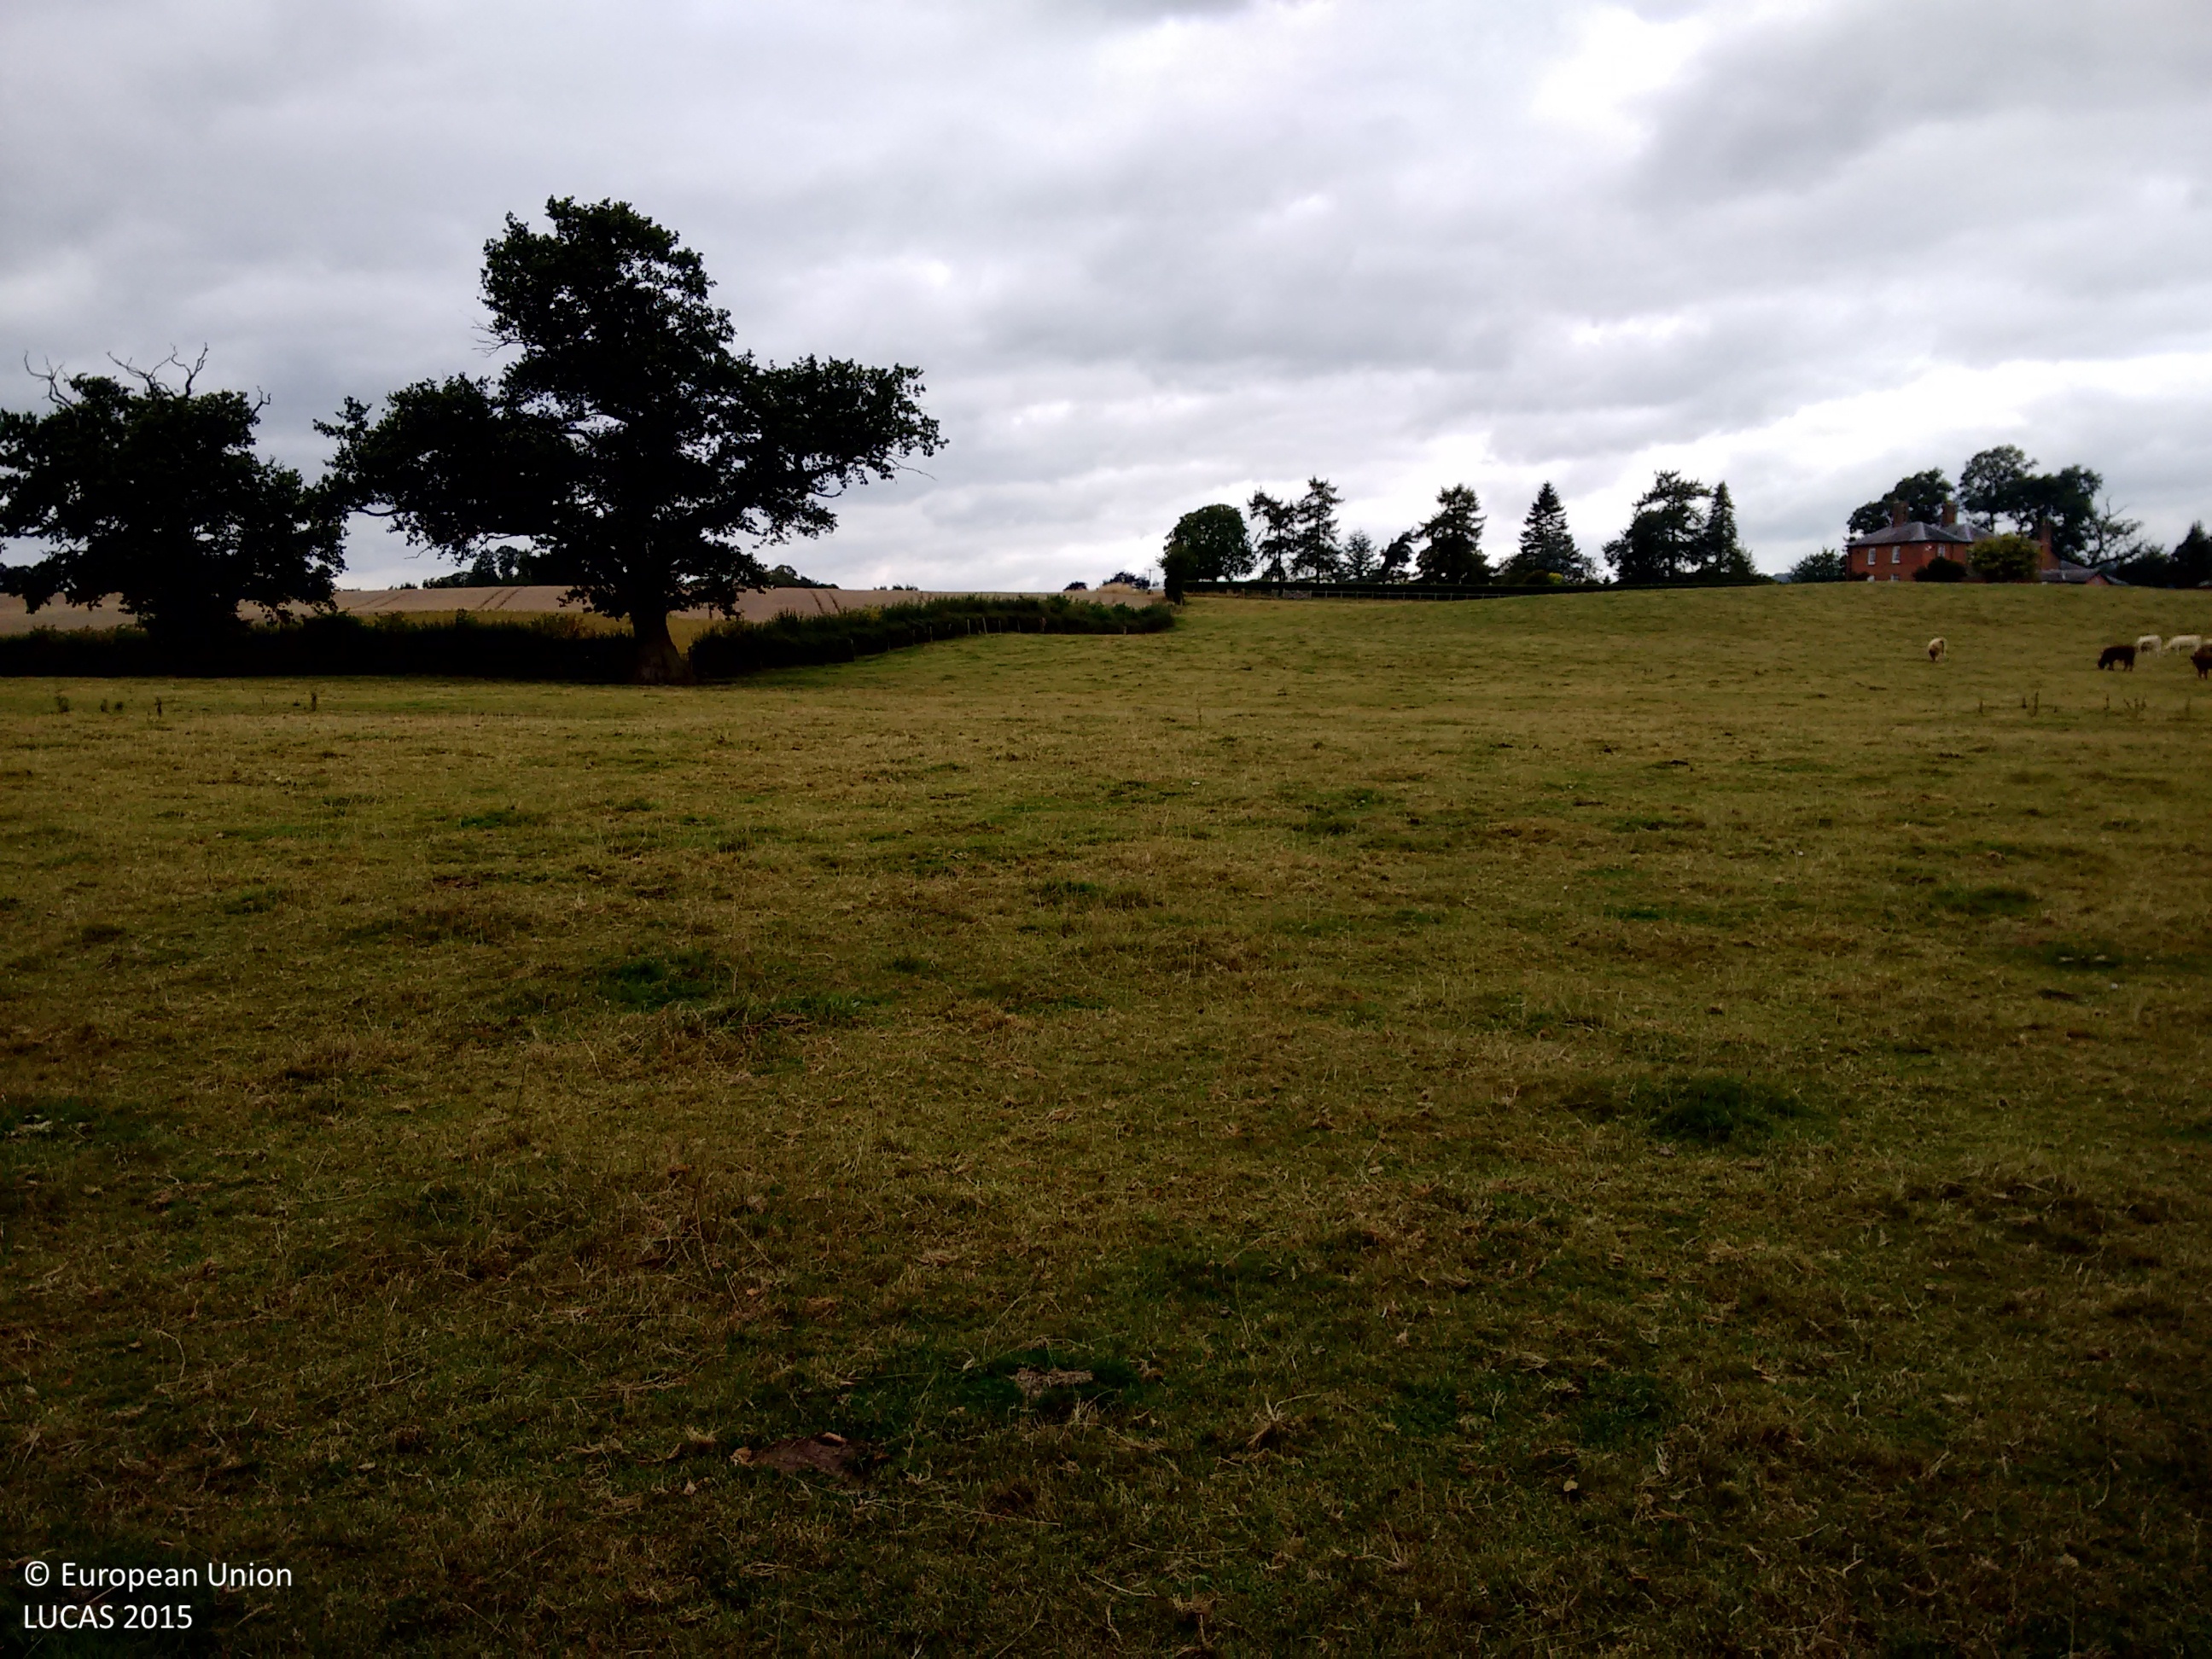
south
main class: Grassland
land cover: Grassland without tree/shrub cover
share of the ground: > 75 %
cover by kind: herbaceous plants 100 %
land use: Agriculture (excluding fallow land and kitchen gardens)
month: September
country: GB
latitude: 52.8953
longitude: -3.0222
